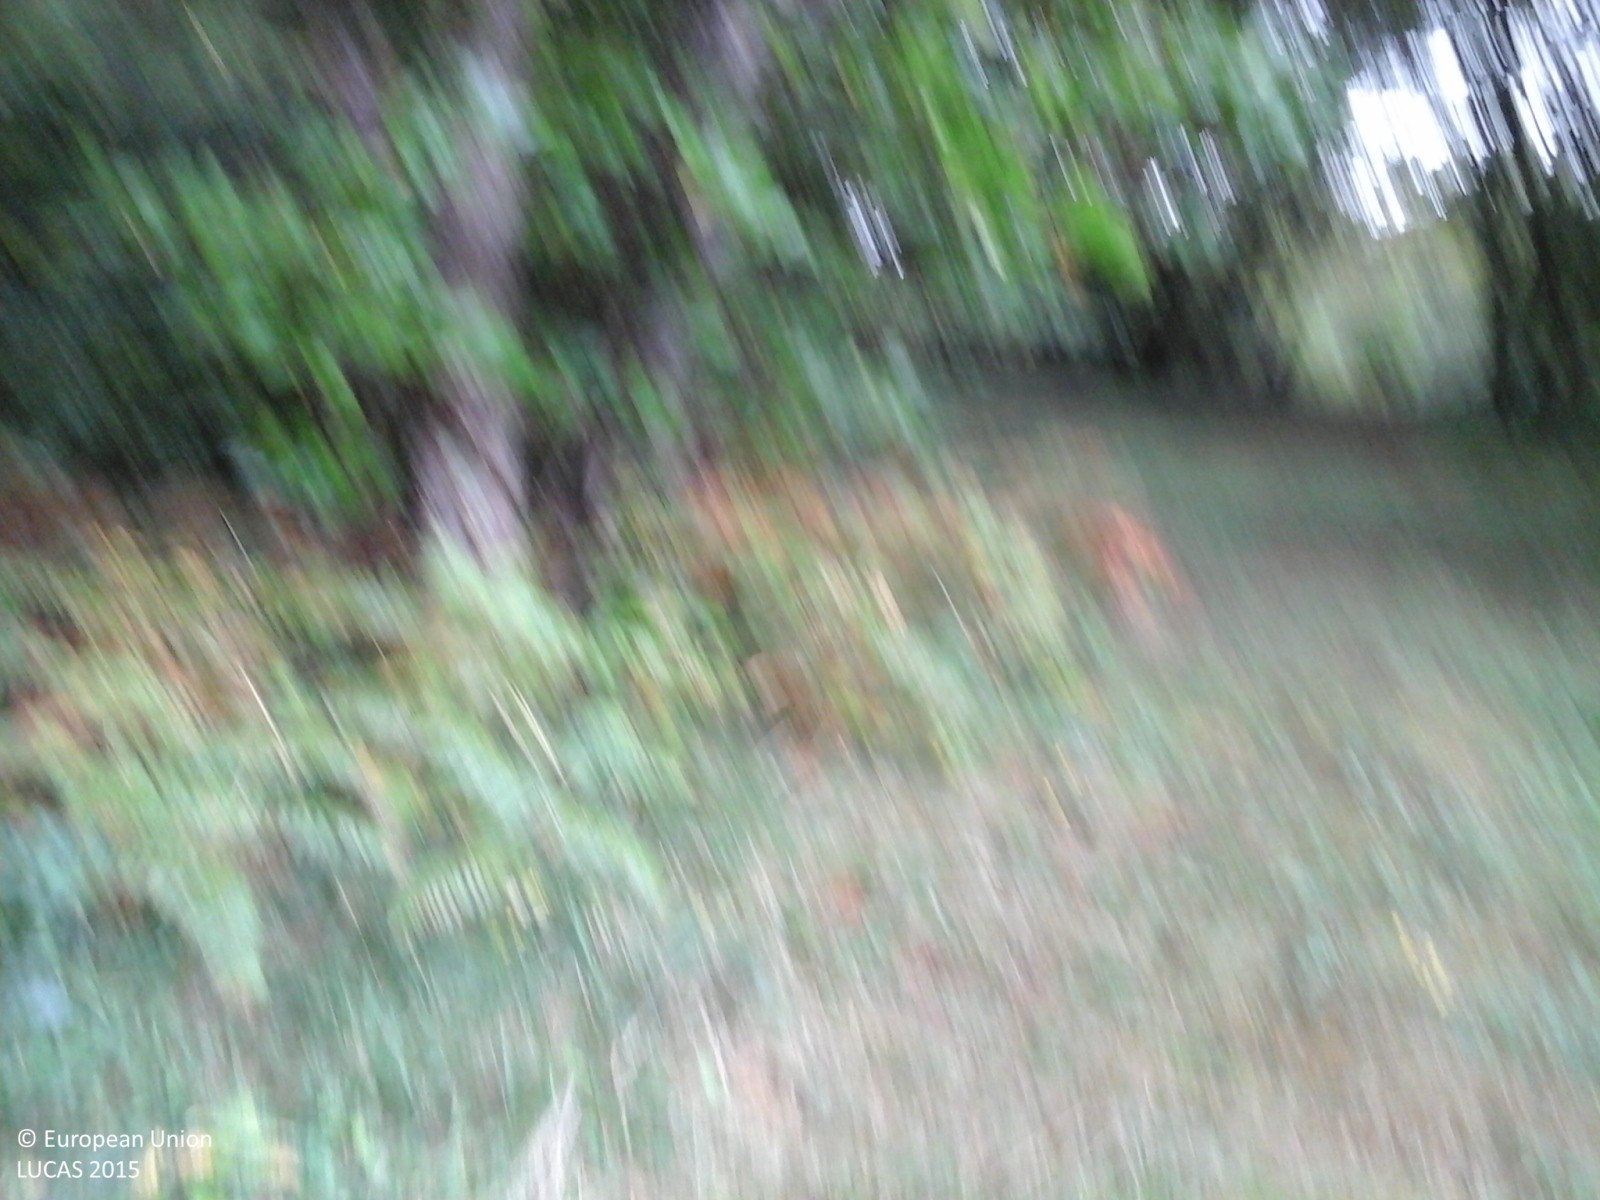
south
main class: Woodland
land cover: Other mixed woodland
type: coniferous forest of the mediterranean region
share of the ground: > 75 %
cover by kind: broadleaved forest trees 60 %, coniferous forest trees 30 %, herbaceous plants 10 %
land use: Semi-natural and natural areas not in use
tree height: > 5 m
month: September
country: IT
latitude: 44.4389
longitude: 9.3858
